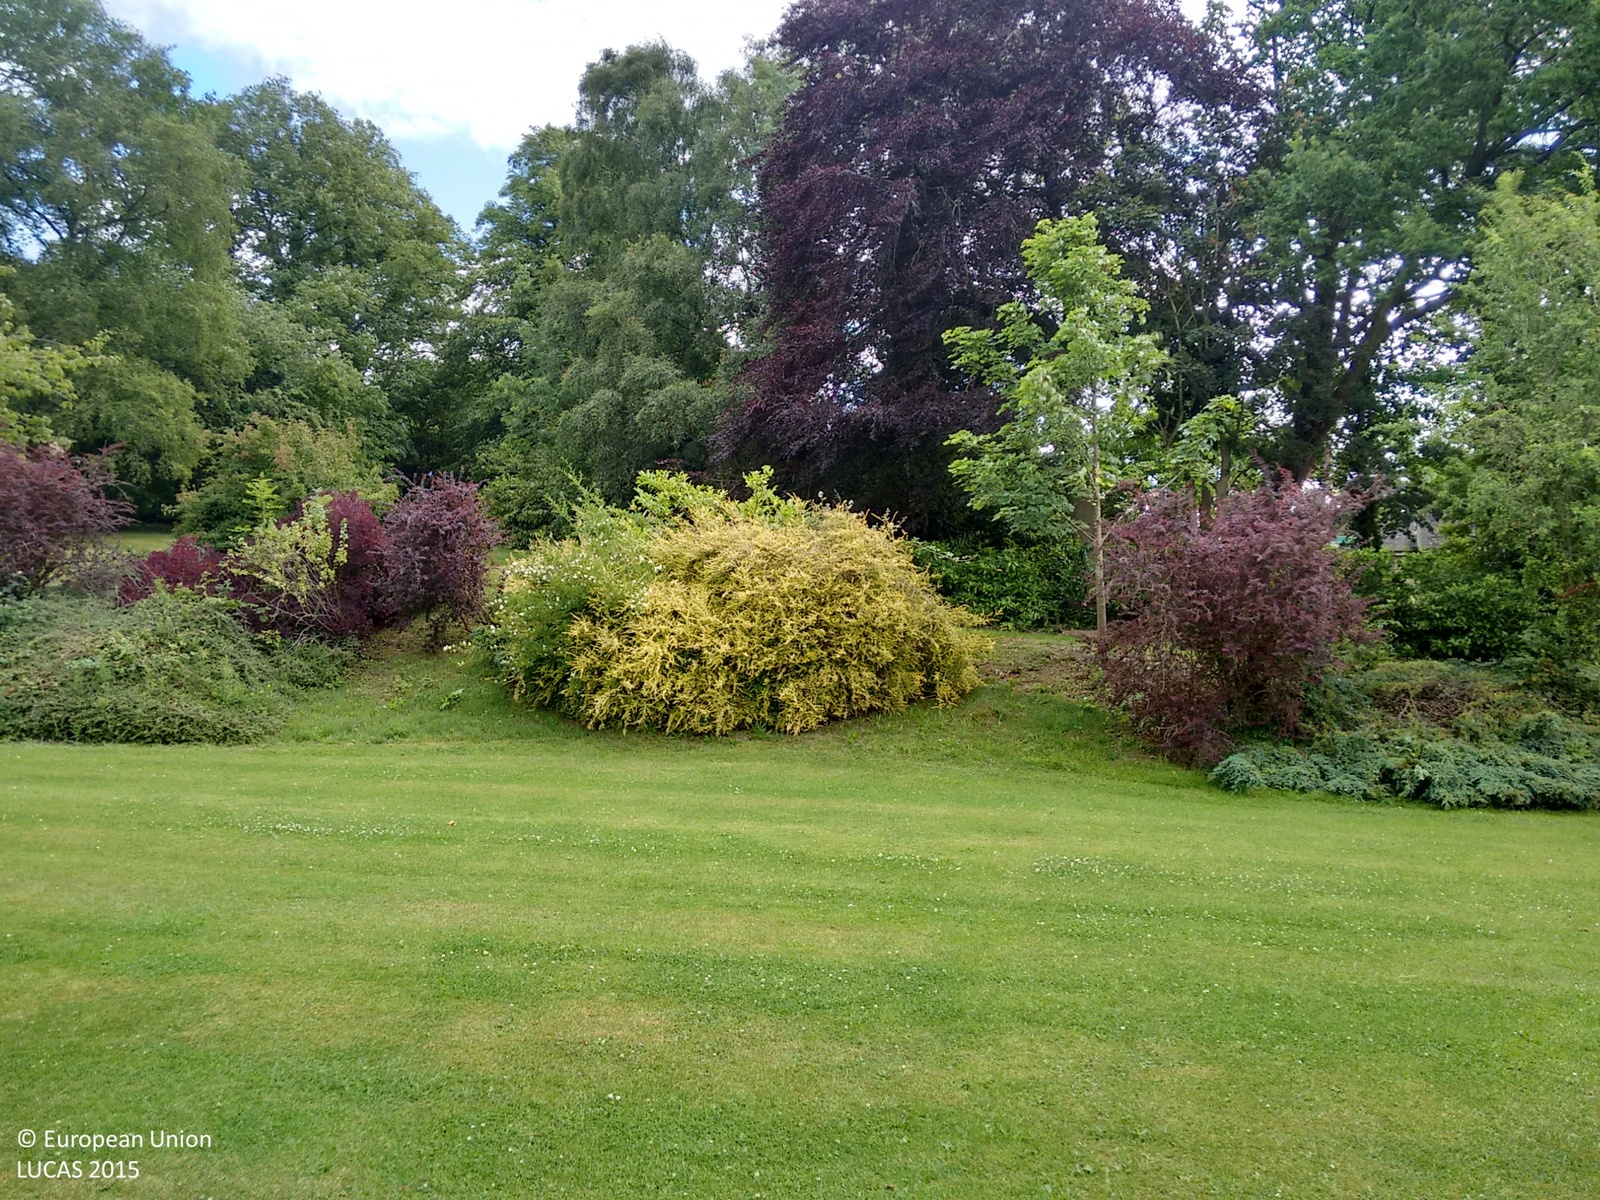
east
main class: Grassland
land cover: Grassland without tree/shrub cover
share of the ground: > 75 %
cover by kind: herbaceous plants 100 %
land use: Community services
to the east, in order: Grassland without tree/shrub cover; Managed hedges; Paved roads, cycling and walking lanes; Broadleaved woodland; Tracks; Grass margins; Managed hedges; Tracks; Electric lines; Grassland without tree/shrub cover; Managed hedges; Grass margins; Managed hedges; Grassland without tree/shrub cover
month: July
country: GB
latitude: 51.9322
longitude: -1.6151
